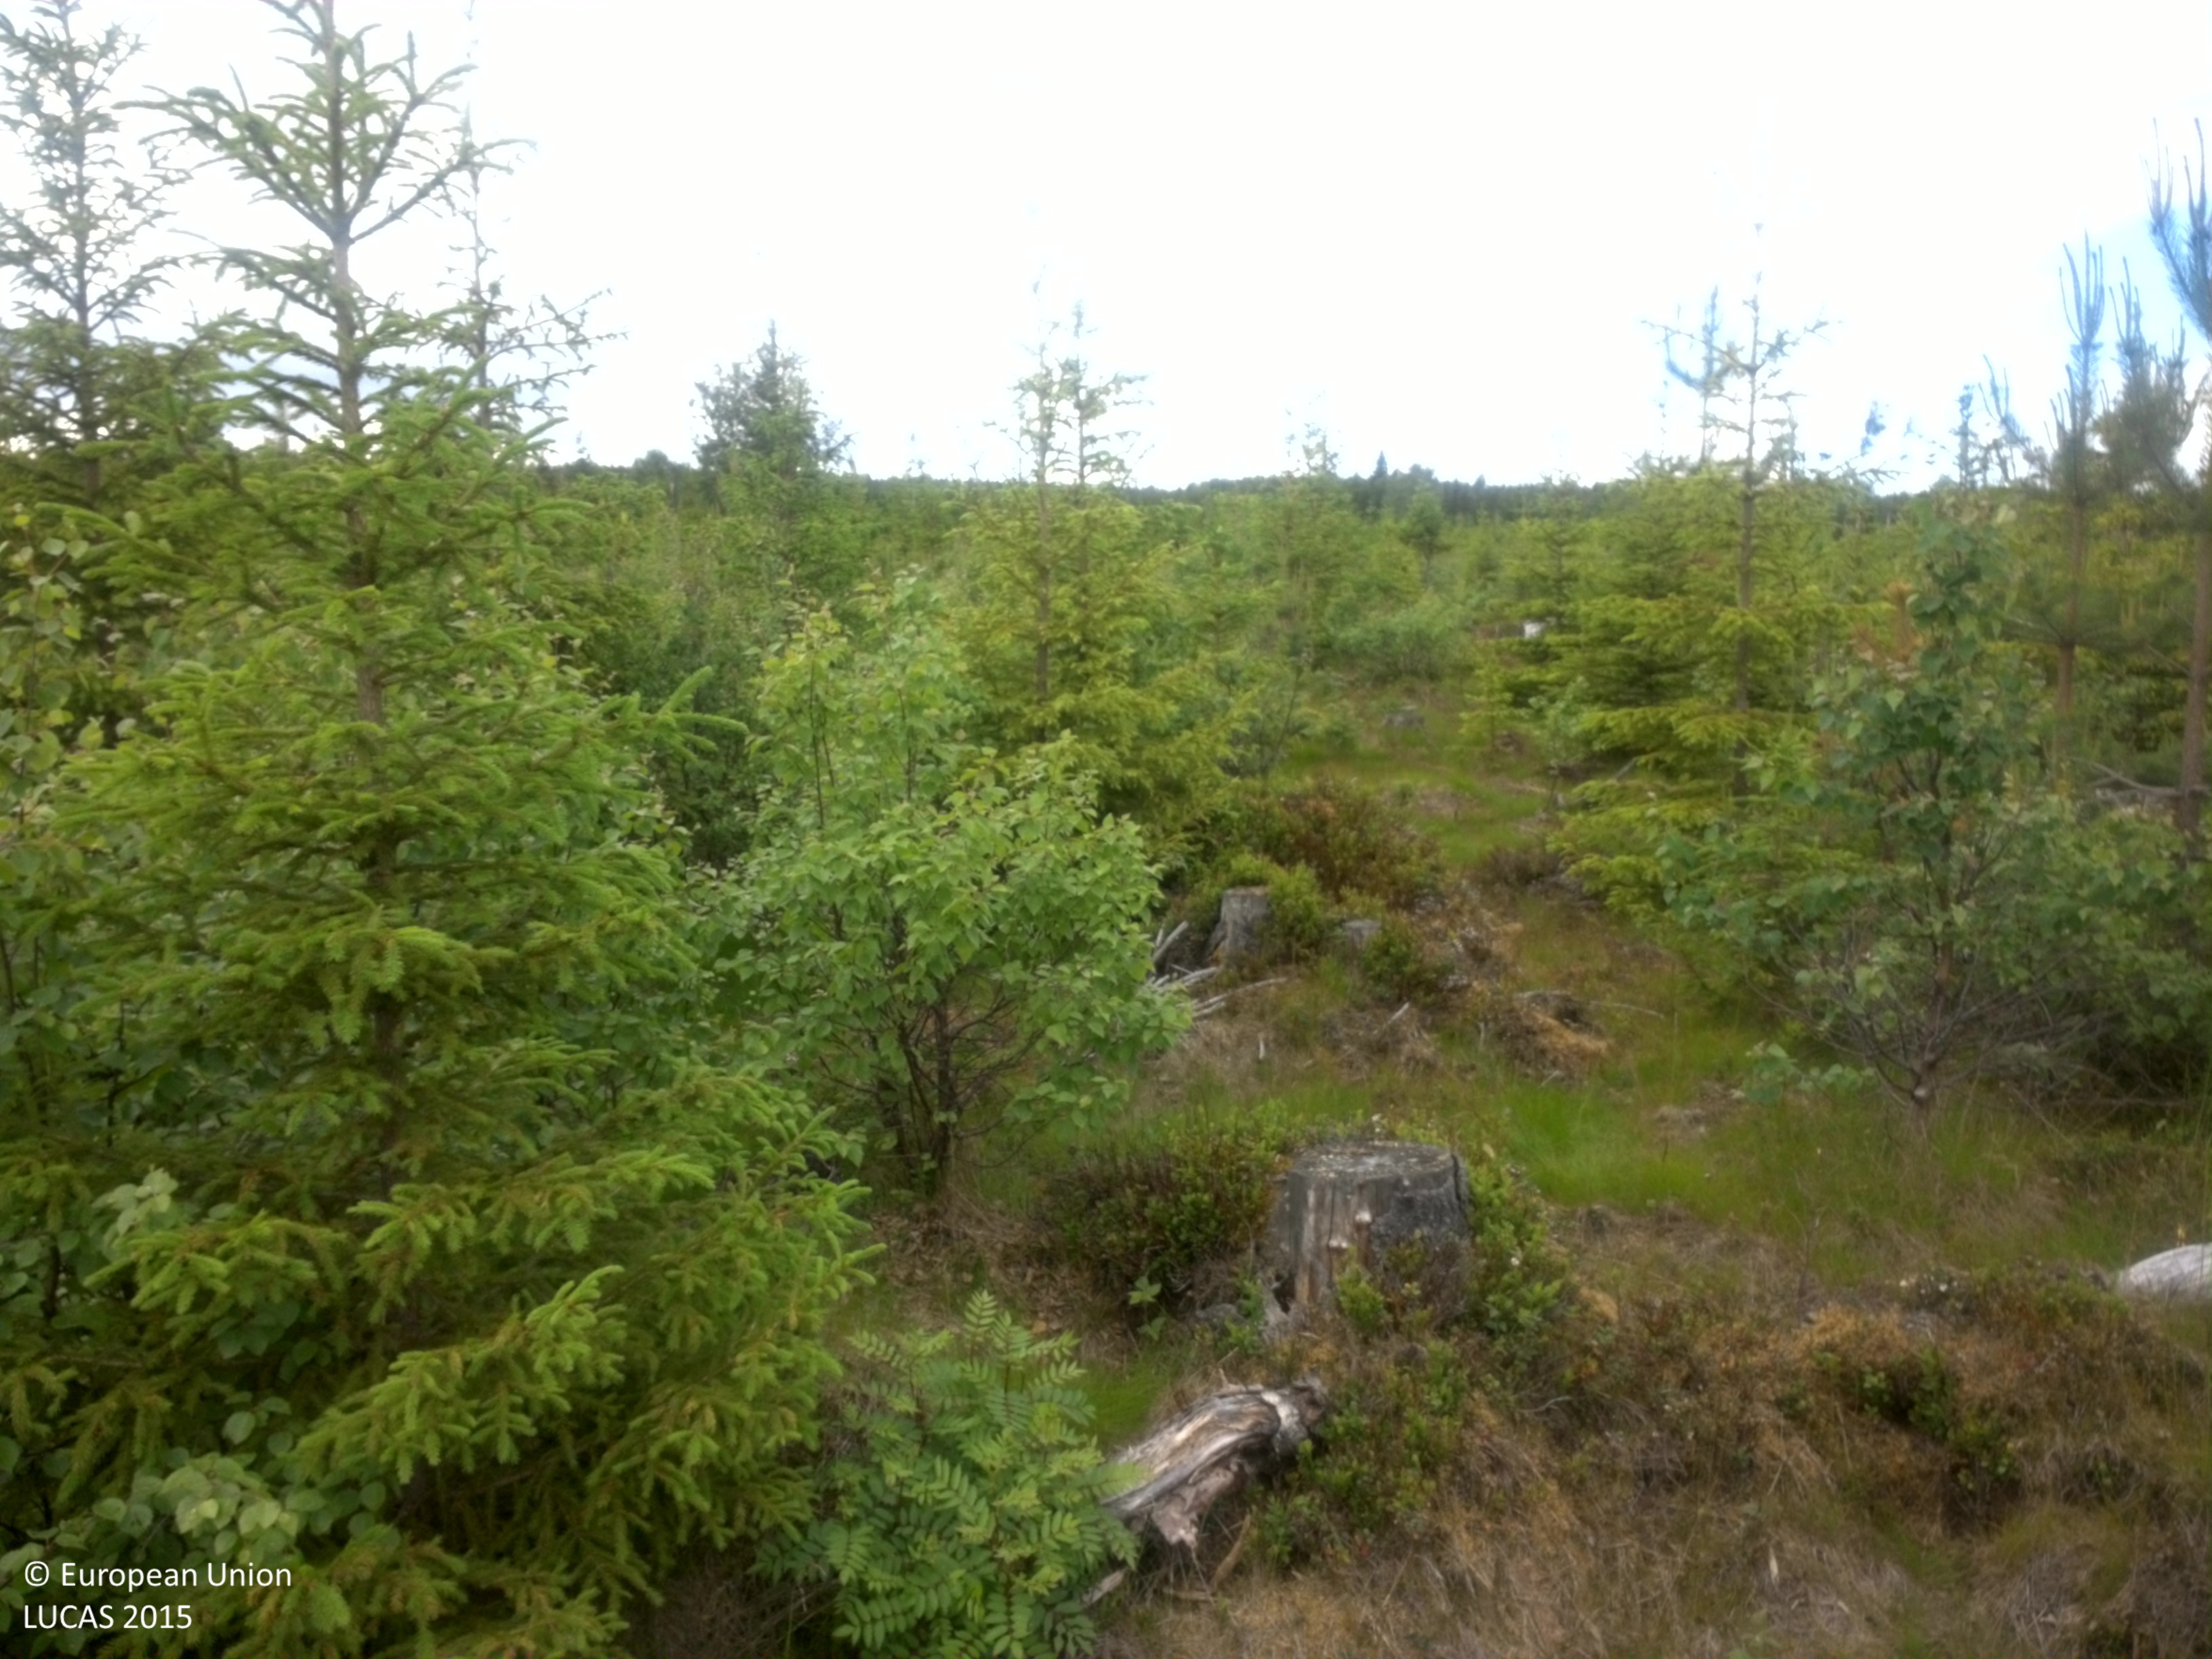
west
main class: Woodland
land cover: Other mixed woodland
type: boreal forest
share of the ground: > 75 %
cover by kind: coniferous forest trees 40 %, broadleaved forest trees 40 %, shrubs 10 %, herbaceous plants 10 %
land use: Forestry
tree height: < 5 m
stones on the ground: 25 - 50 %
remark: Clear cut
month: July
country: SE
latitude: 64.6262
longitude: 20.3277
